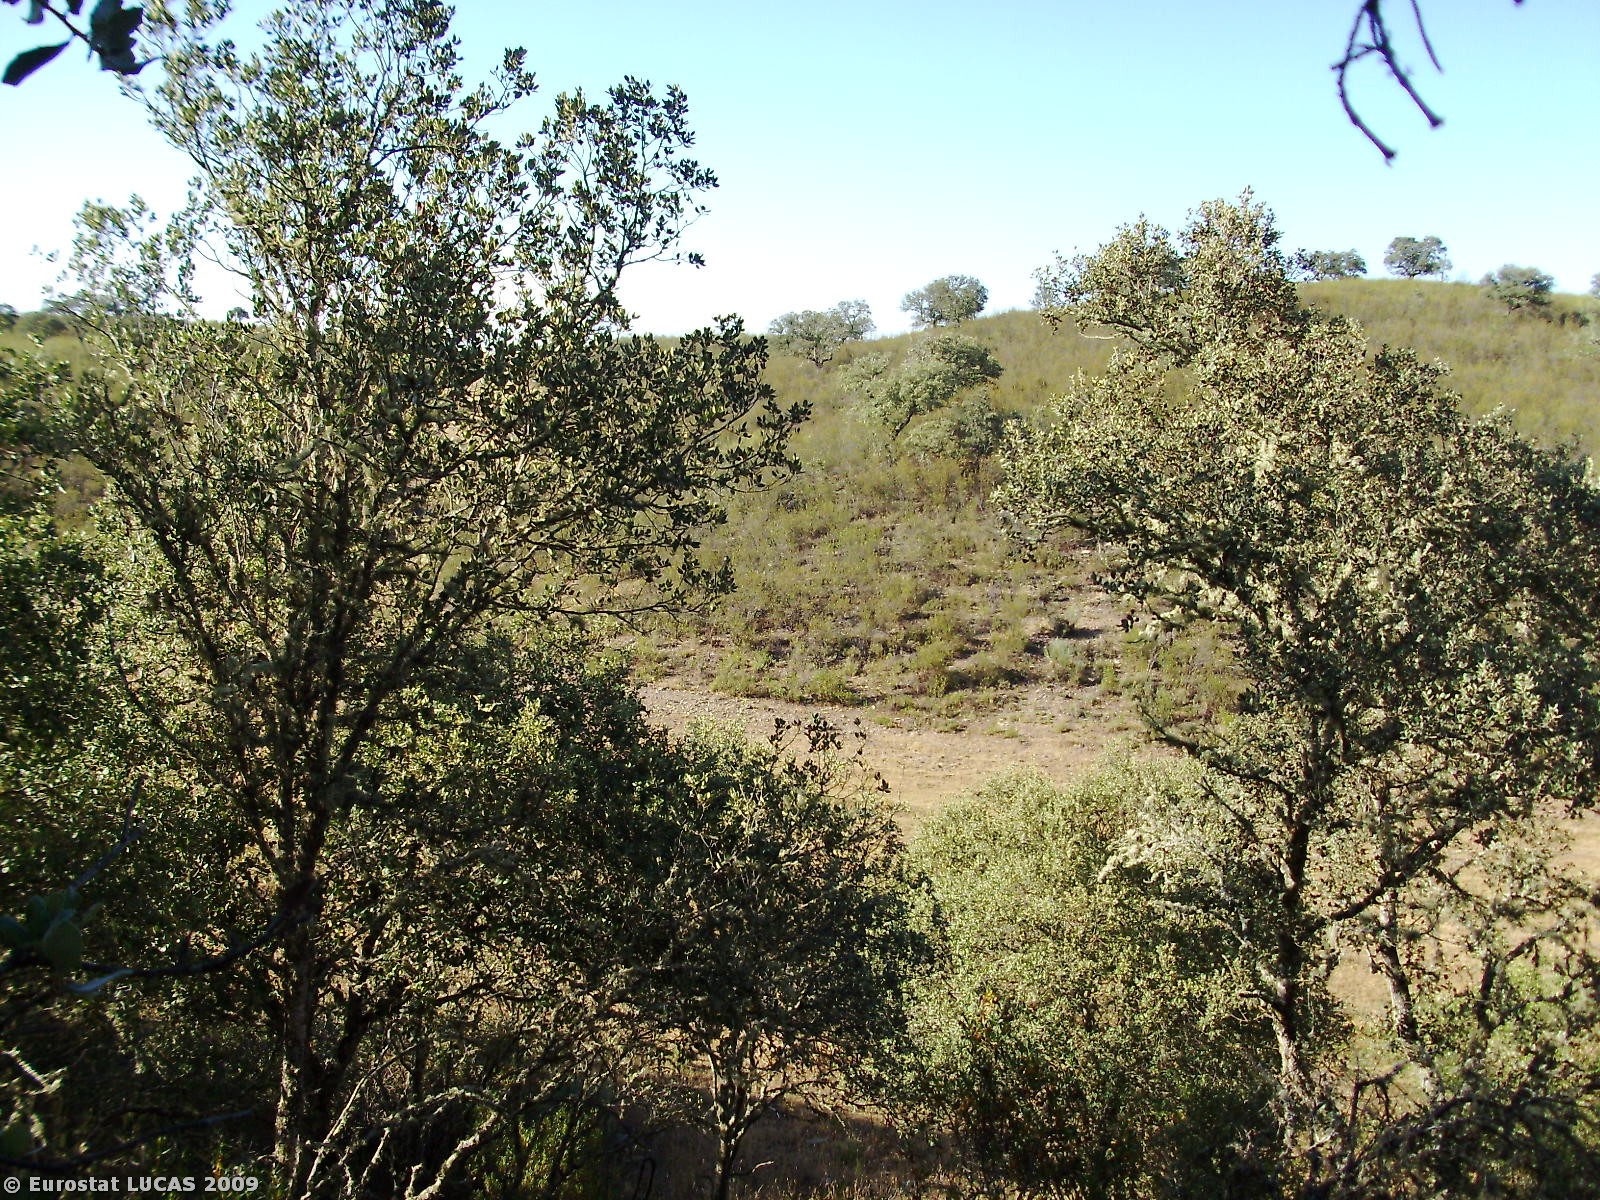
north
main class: Woodland
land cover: Broadleaved woodland
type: broadleaved evergreen forest
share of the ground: 25 - 50 %
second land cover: Shrubland with sparse tree cover
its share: 50 - 75 %
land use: Forestry
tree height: > 5 m
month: April
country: PT
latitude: 39.5281
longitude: -7.5096
